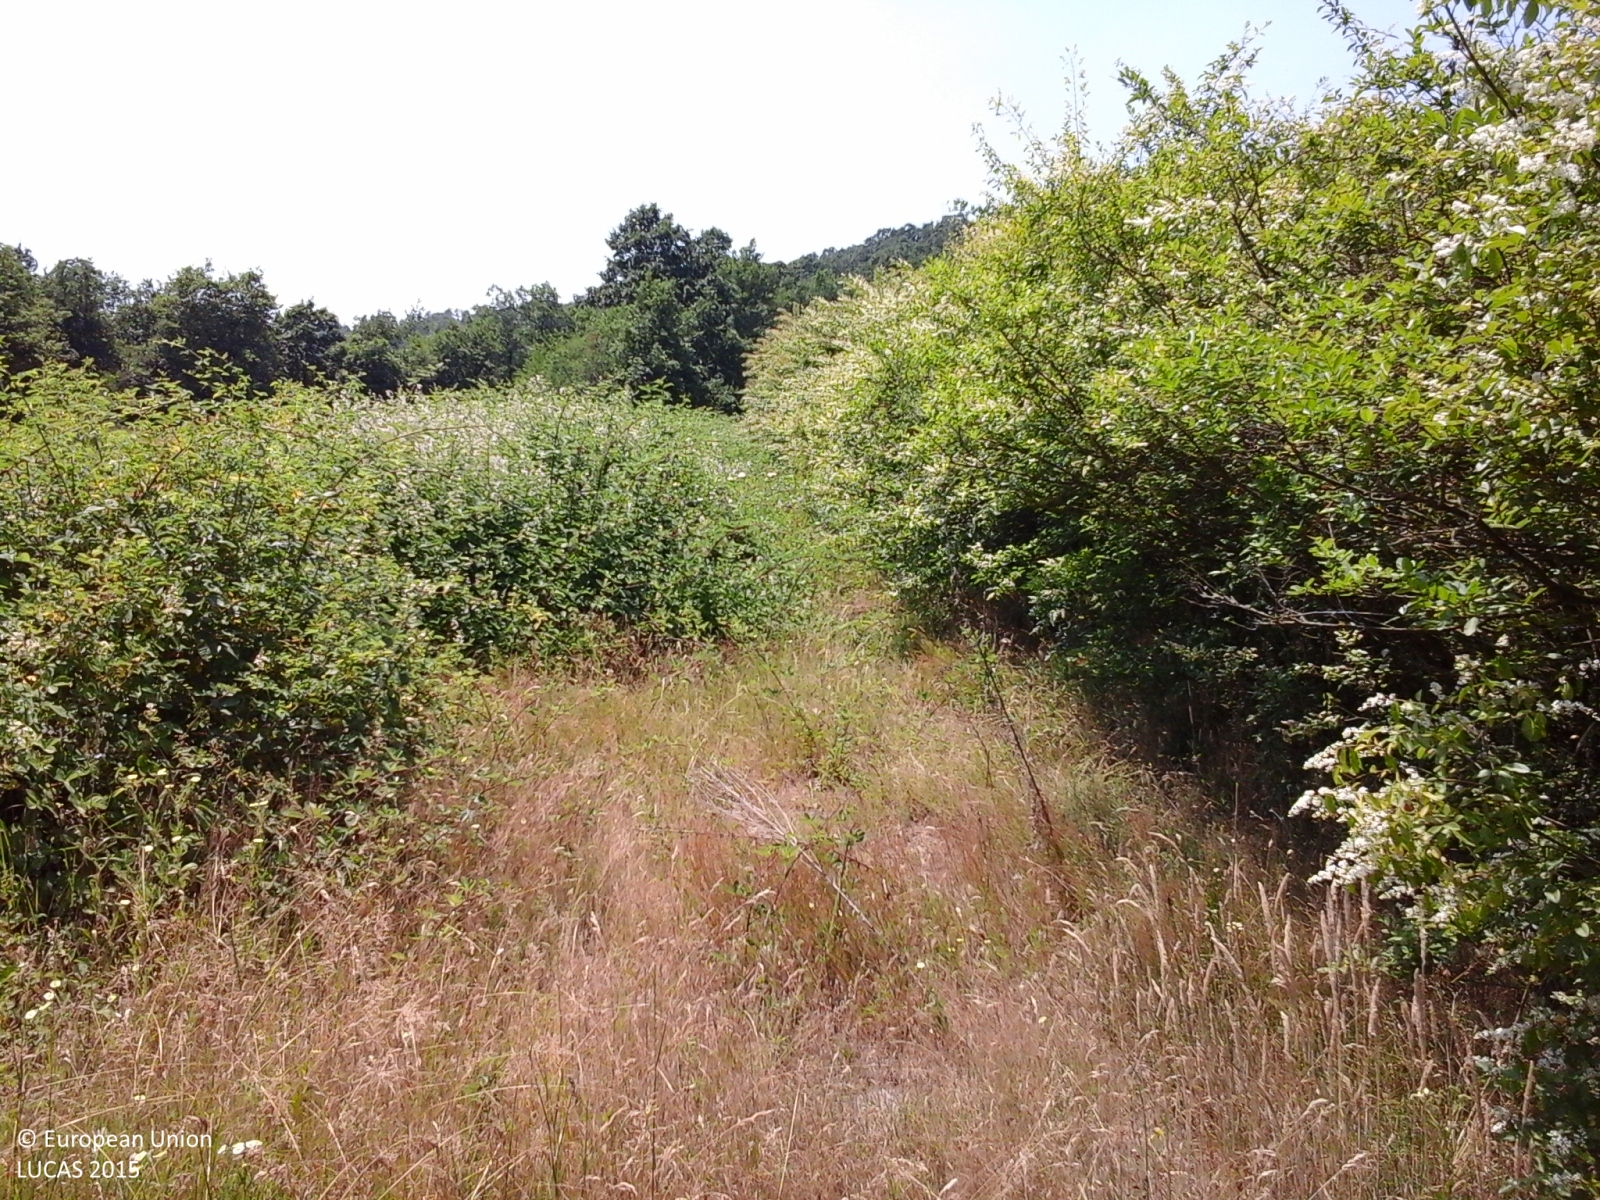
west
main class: Grassland
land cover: Spontaneously vegetated surfaces
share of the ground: > 75 %
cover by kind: herbaceous plants 100 %
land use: Abandoned areas
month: June
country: IT
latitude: 44.7206
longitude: 8.6519
